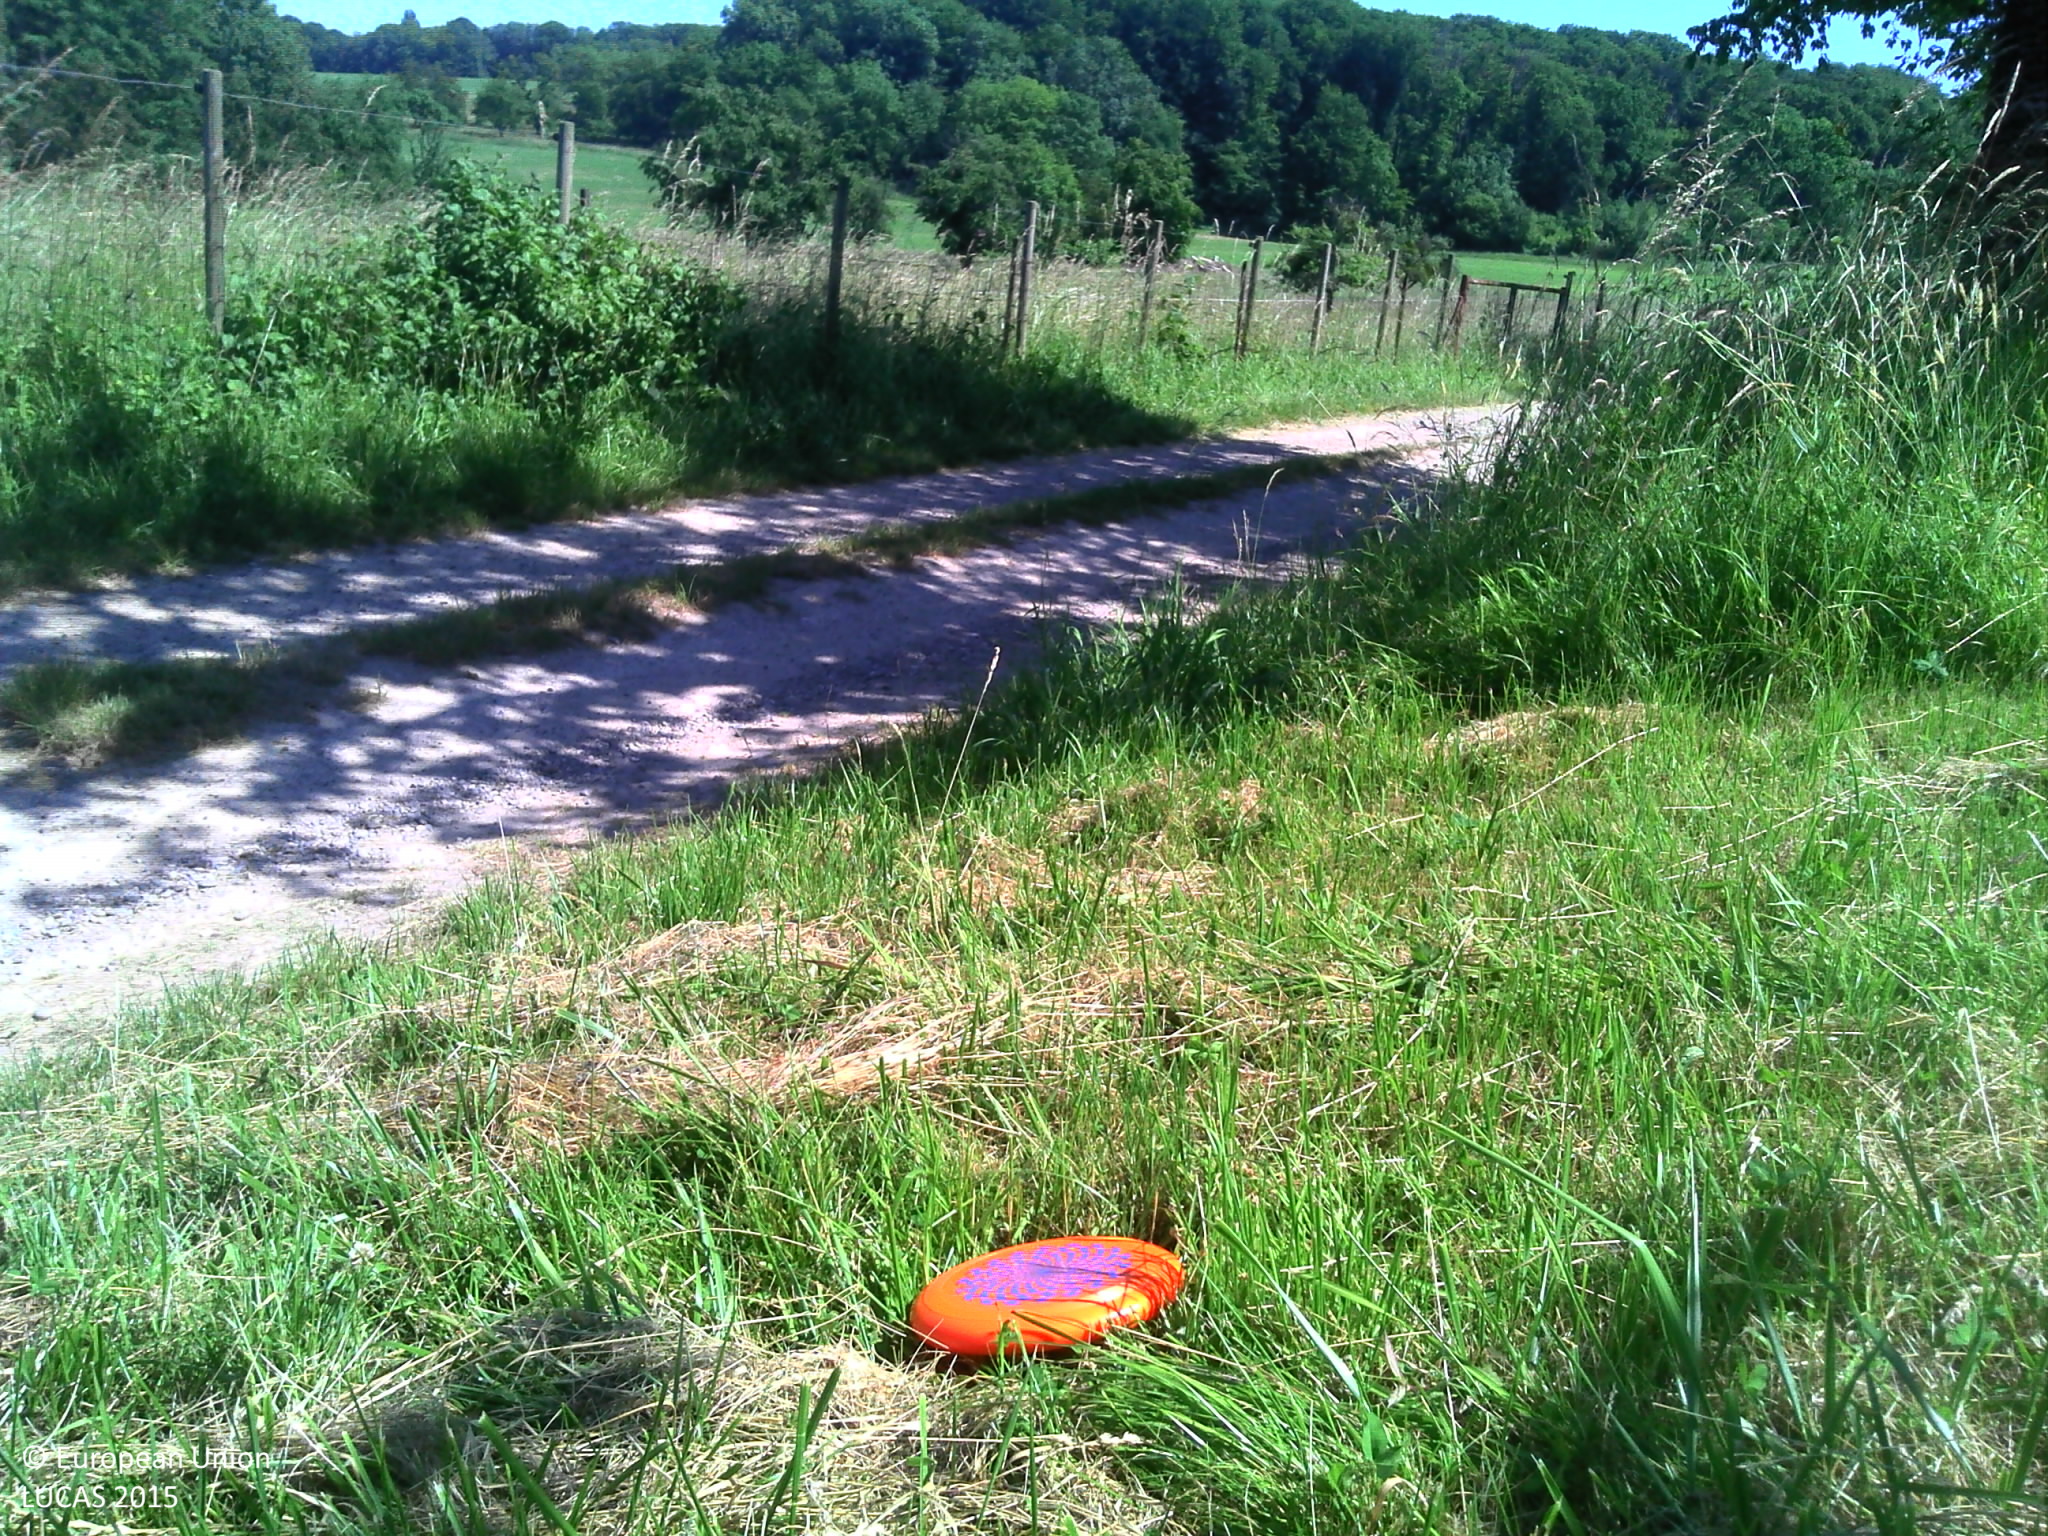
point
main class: Cropland
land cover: Cherry fruit
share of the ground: > 75 %
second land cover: Grassland without tree/shrub cover
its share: > 75 %
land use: Agriculture (excluding fallow land and kitchen gardens)
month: June
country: FR
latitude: 47.6349
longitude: 7.4063
